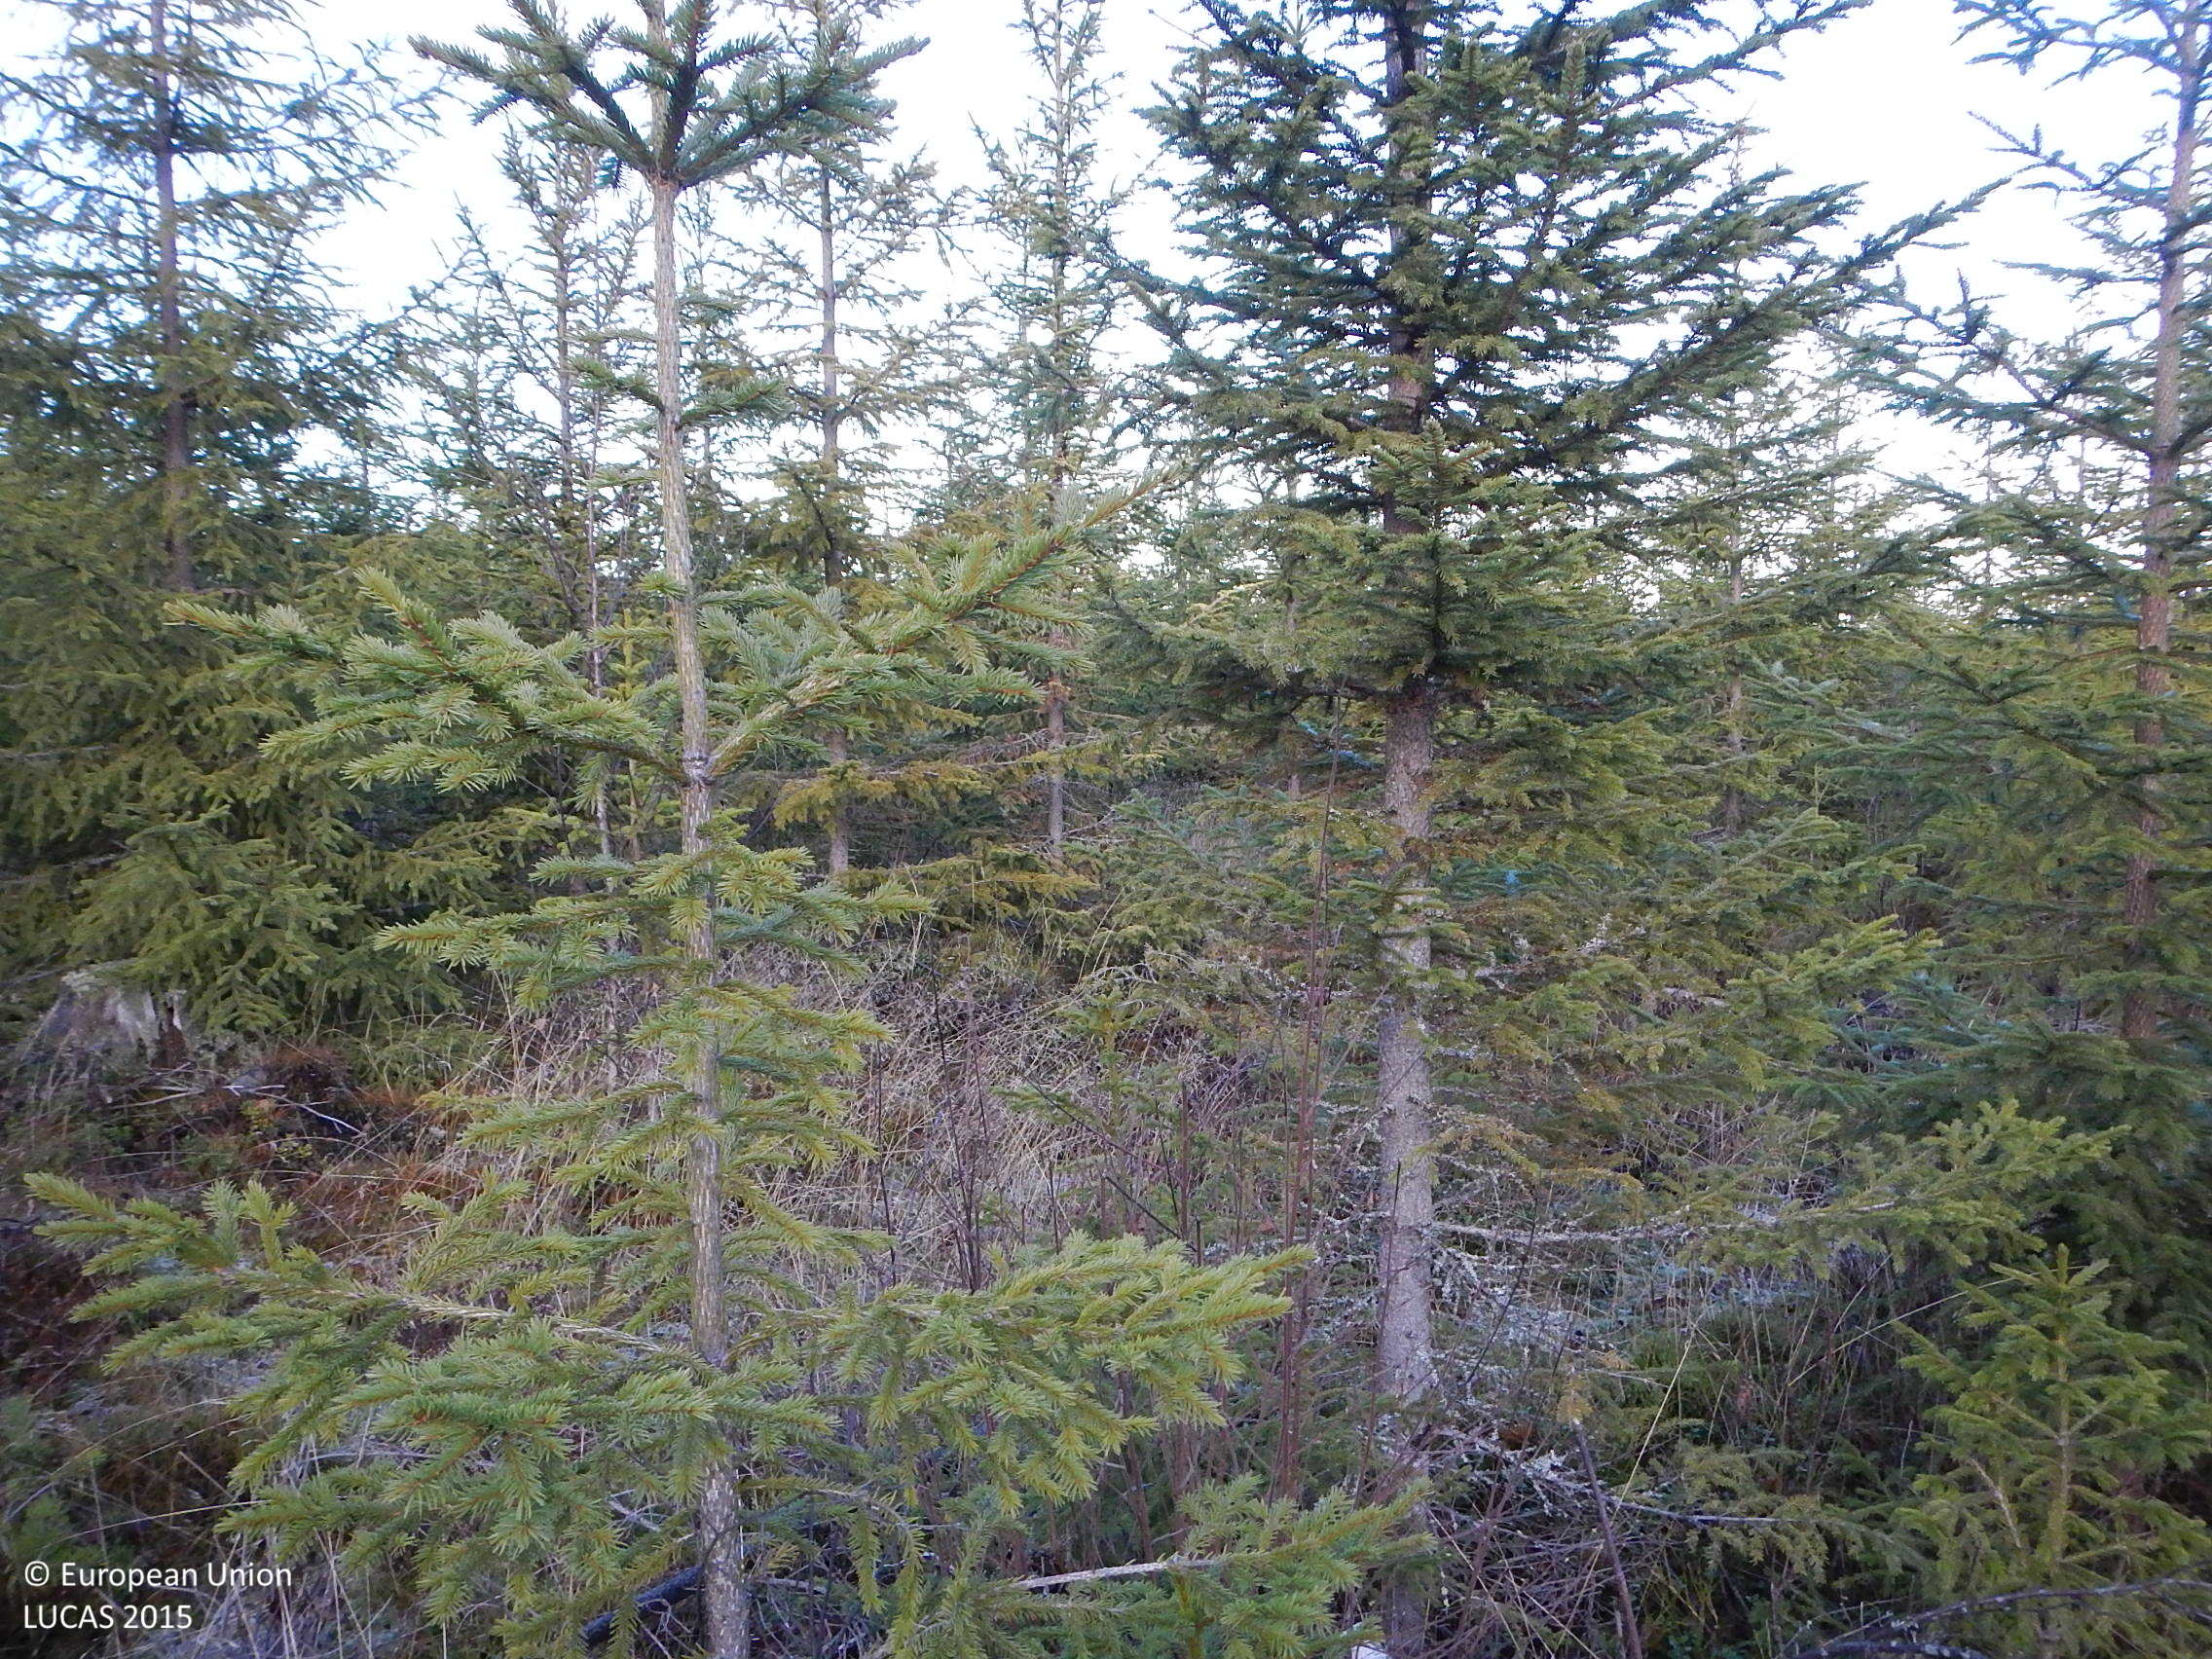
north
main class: Woodland
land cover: Spruce dominated coniferous woodland
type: boreal forest
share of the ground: 25 - 50 %
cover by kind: coniferous forest trees 40 %, shrubs 25 %, herbaceous plants 25 %, lichens and mosses 10 %
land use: Forestry
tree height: < 5 m
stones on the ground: < 10 %
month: November
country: SE
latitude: 61.5649
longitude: 16.1397
